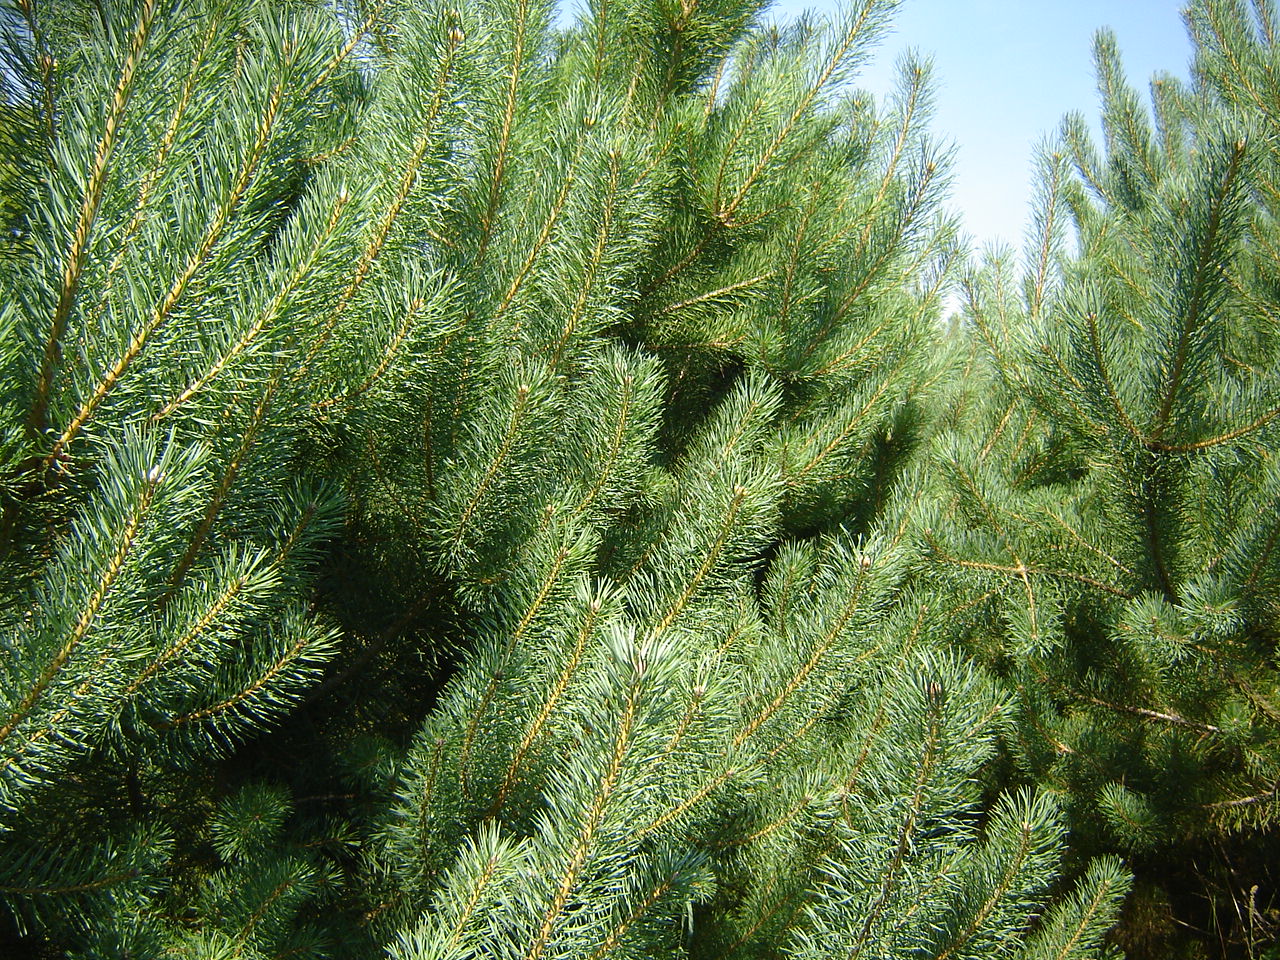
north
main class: Woodland
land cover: Pine dominated coniferous woodland
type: hemiboreal forest and nemoral coniferous forest and mixed broadleaved-coniferous forest
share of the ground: > 75 %
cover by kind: coniferous forest trees 90 %, herbaceous plants 10 %
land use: Forestry
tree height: < 5 m
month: August
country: LT
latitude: 55.2115
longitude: 24.9634
